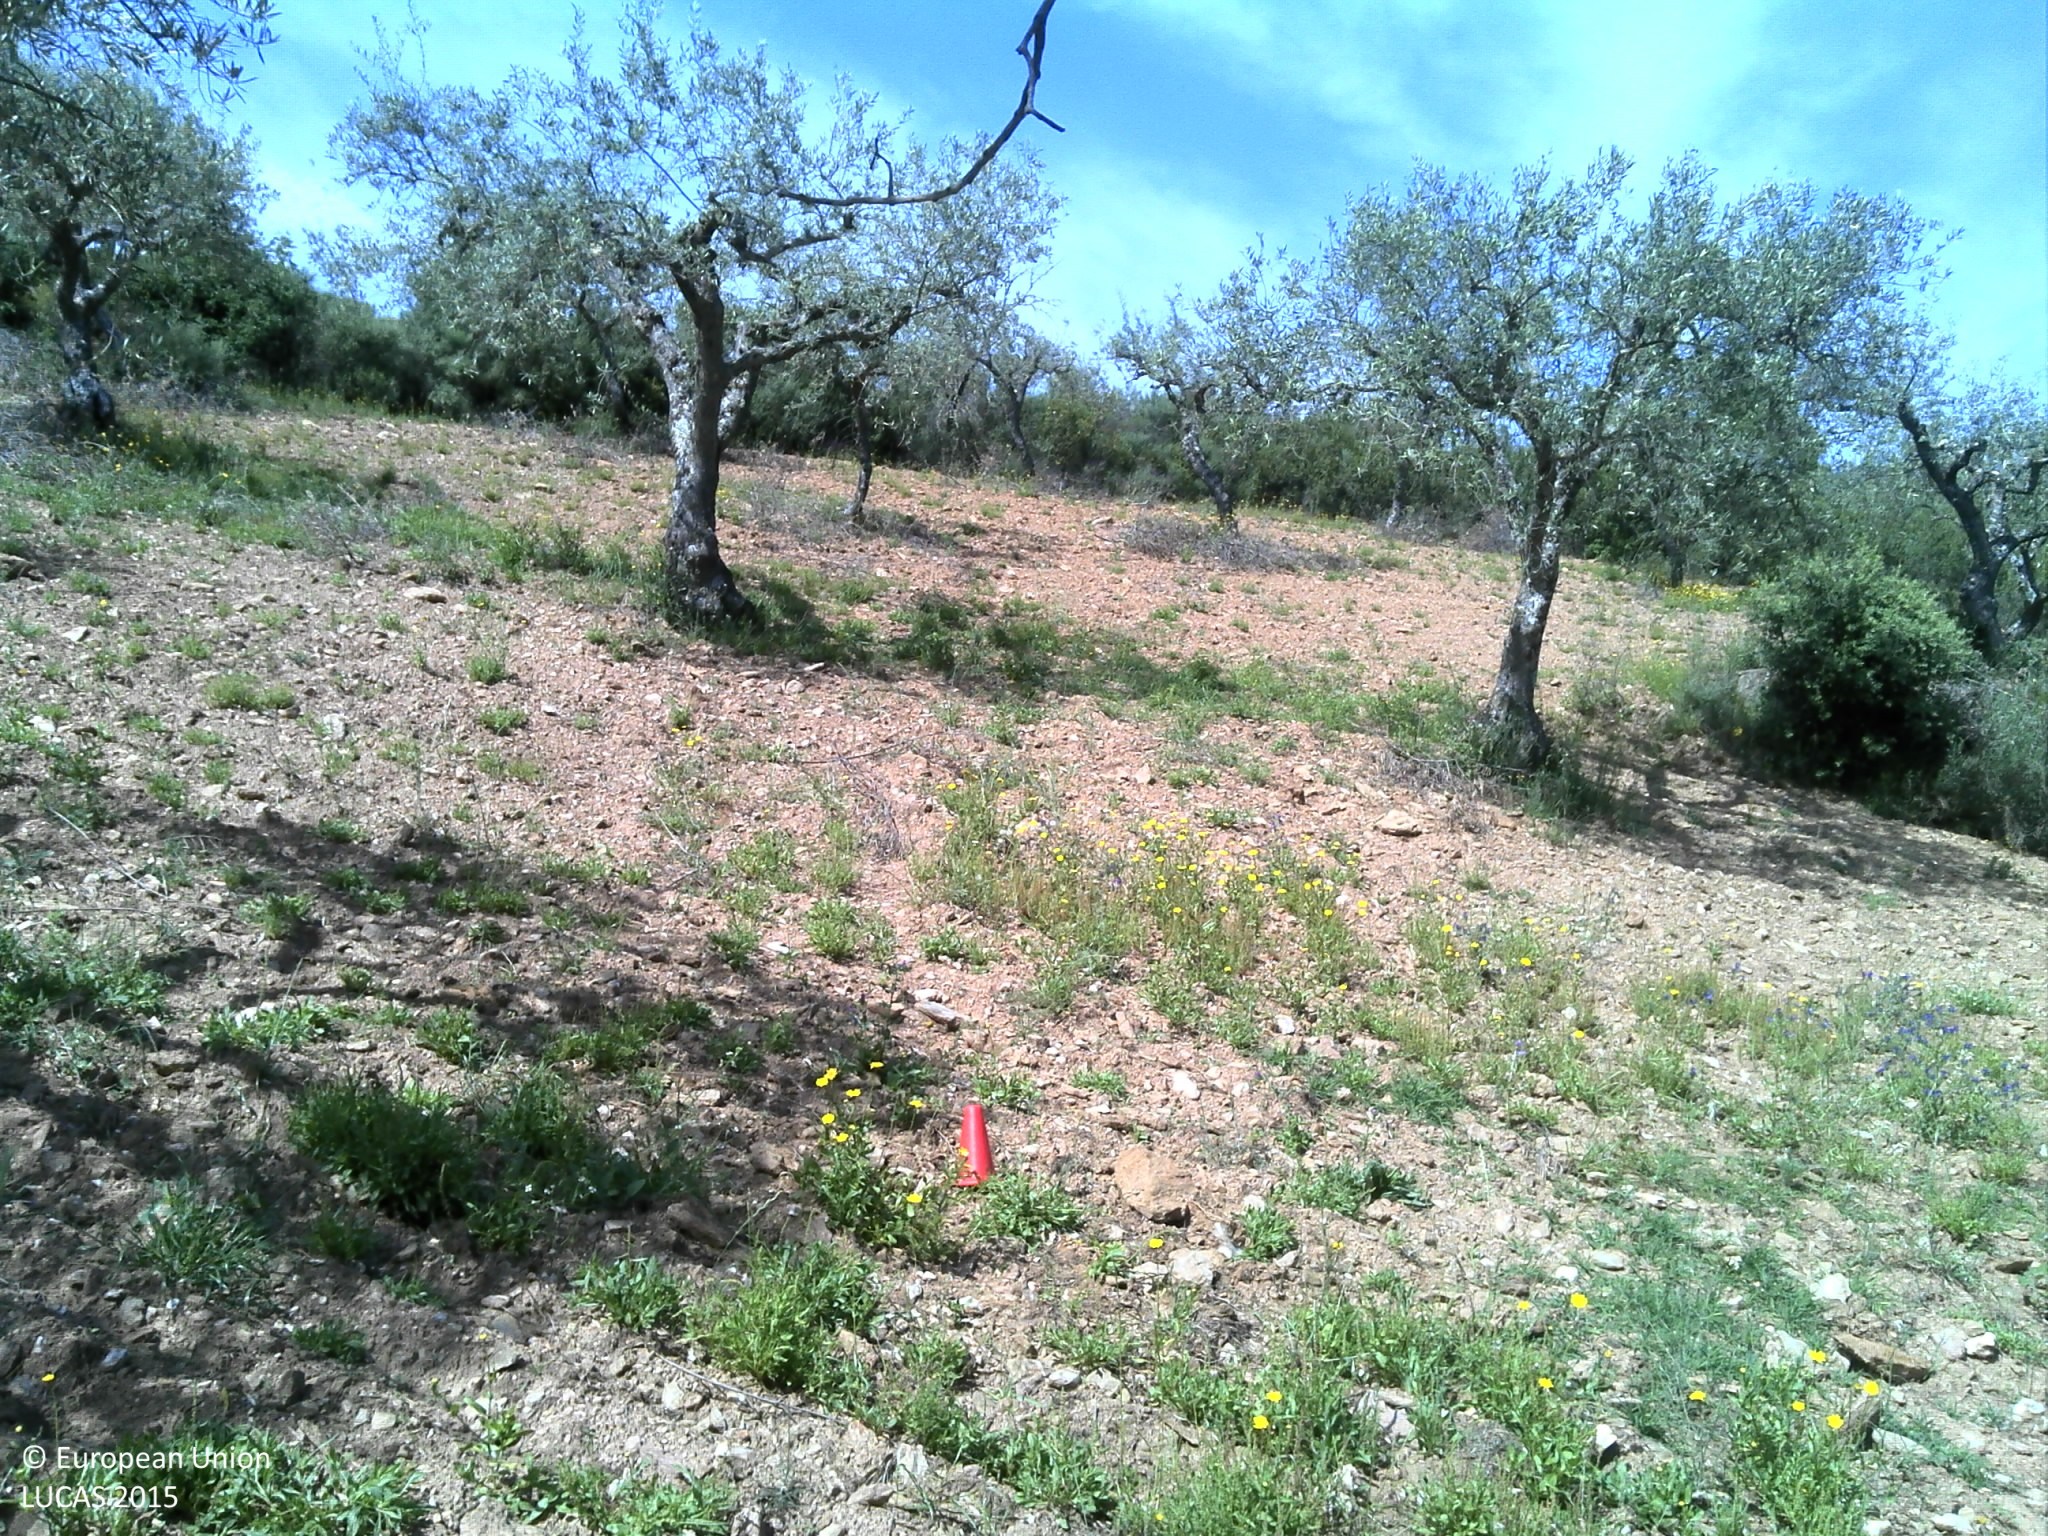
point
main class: Cropland
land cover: Olive groves
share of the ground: 25 - 50 %
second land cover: Spontaneously vegetated surfaces
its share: 10 - 25 %
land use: Agriculture (excluding fallow land and kitchen gardens)
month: May
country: PT
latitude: 41.5800
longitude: -7.0652
